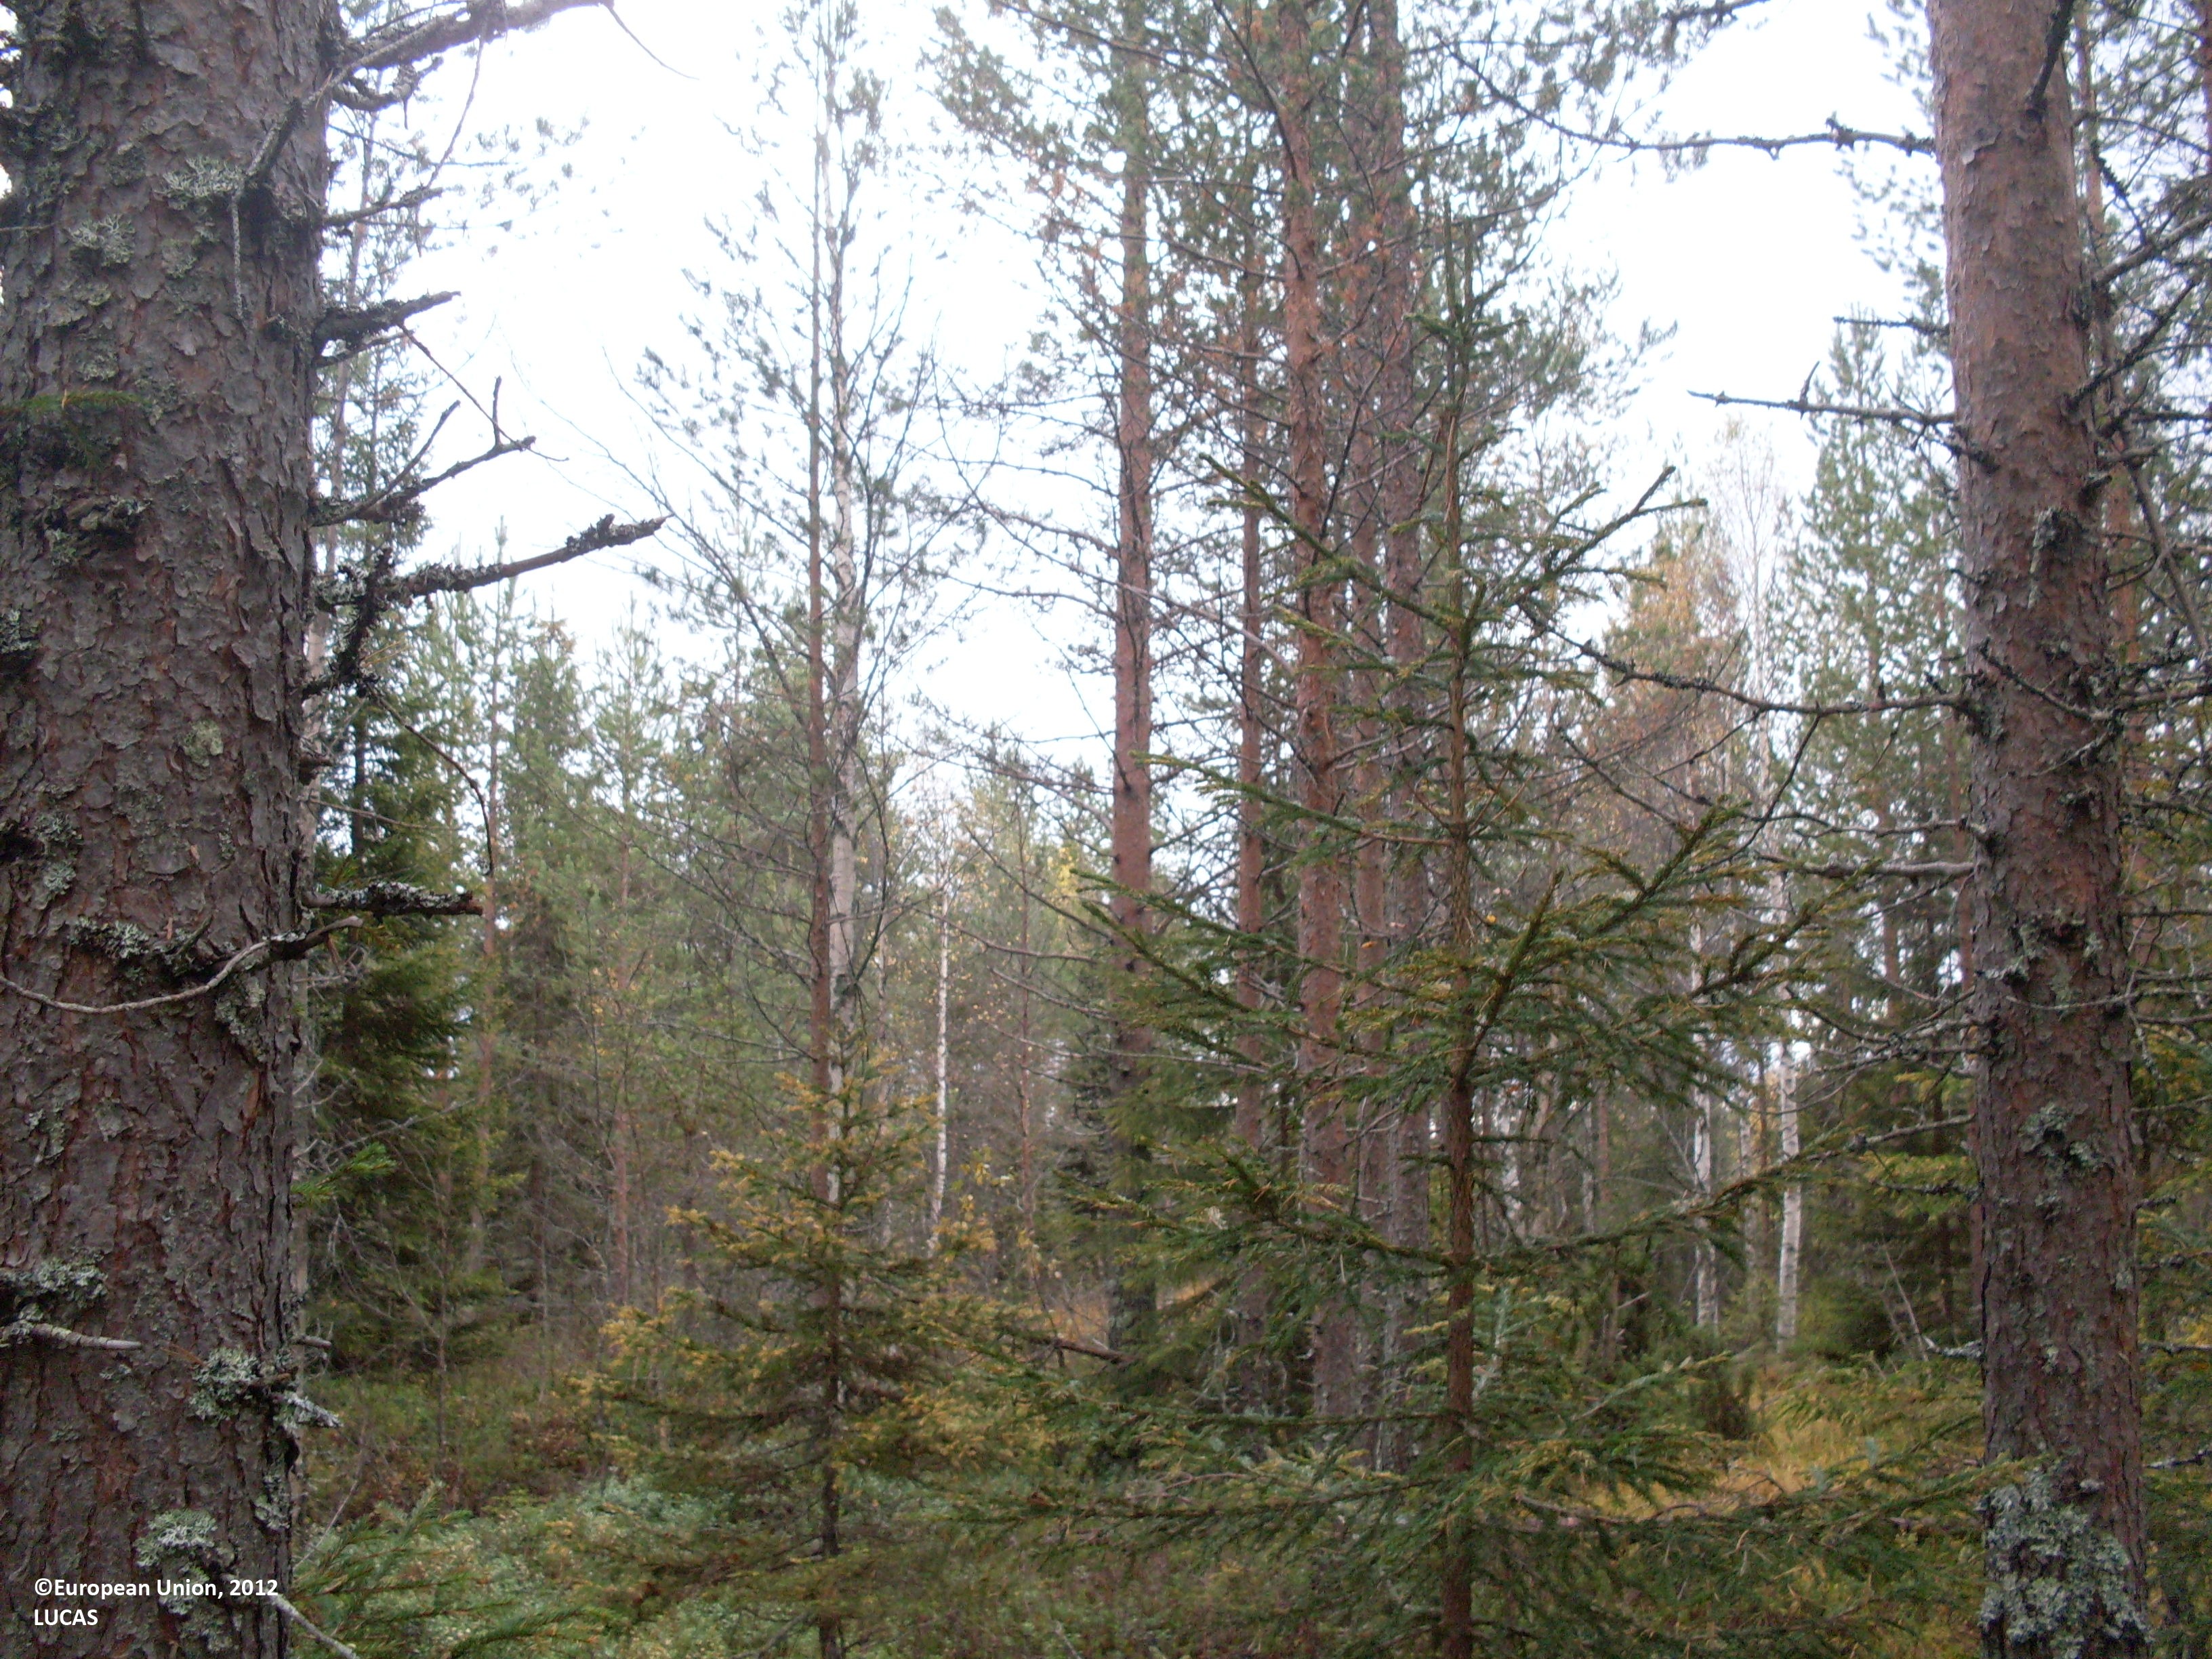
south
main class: Woodland
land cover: Pine dominated mixed woodland
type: boreal forest
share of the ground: 50 - 75 %
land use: Forestry
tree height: > 5 m
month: September
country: FI
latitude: 64.8784
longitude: 28.6916
